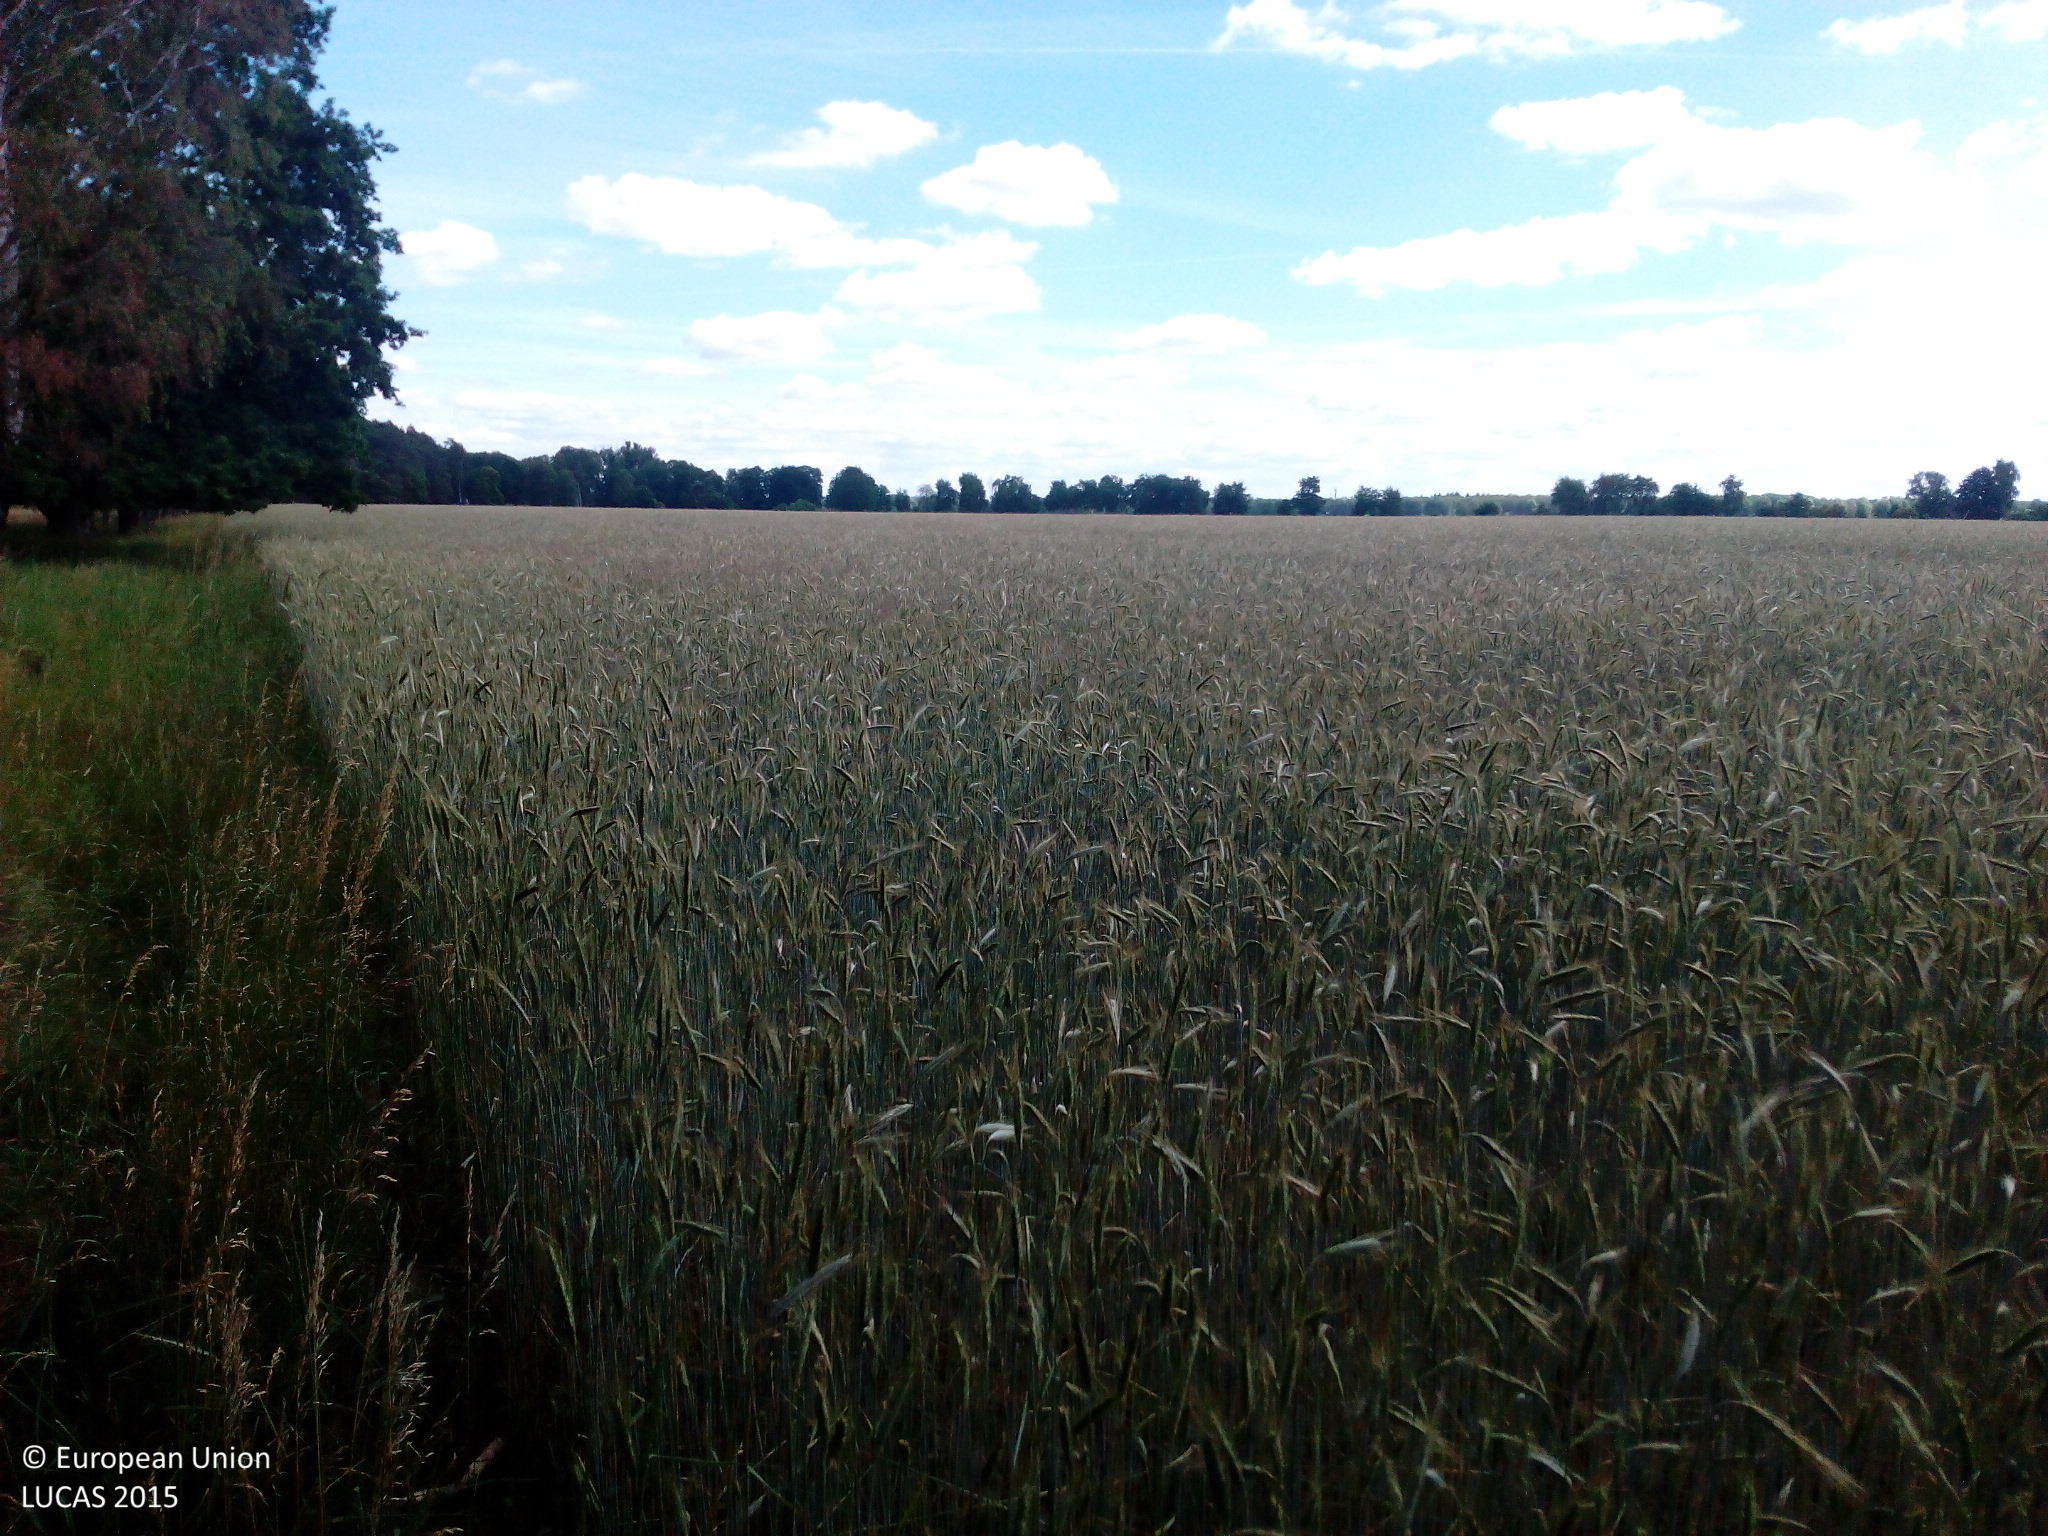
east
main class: Woodland
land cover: Broadleaved woodland
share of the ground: > 75 %
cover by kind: broadleaved forest trees 75 %, herbaceous plants 25 %
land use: Agriculture (excluding fallow land and kitchen gardens)
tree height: > 5 m
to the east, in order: Rye
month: June
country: DE
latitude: 52.8211
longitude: 13.1606
